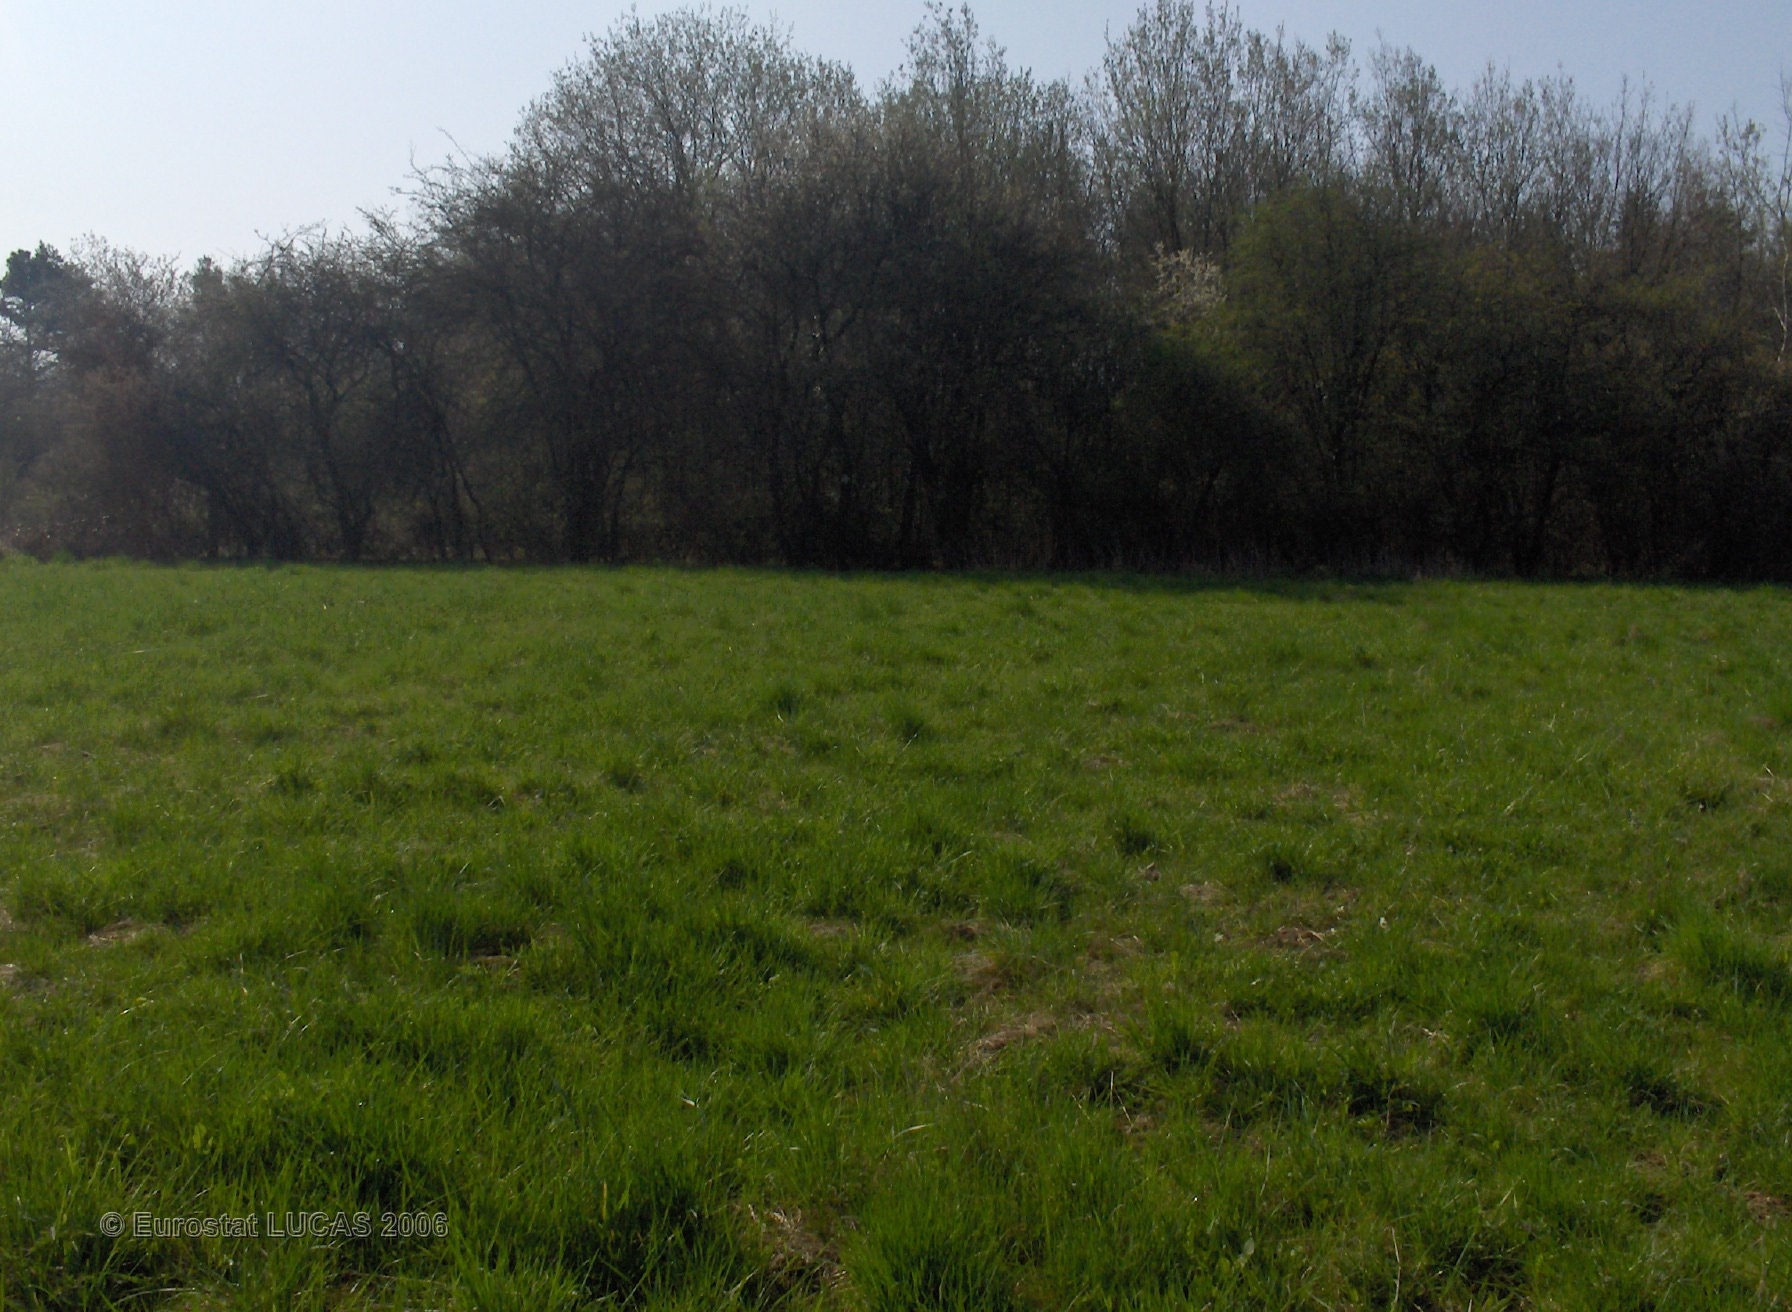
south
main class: Grassland
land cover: Grassland without tree/shrub cover
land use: Agriculture (excluding fallow land and kitchen gardens)
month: April
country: BE
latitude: 50.0725
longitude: 4.5610
